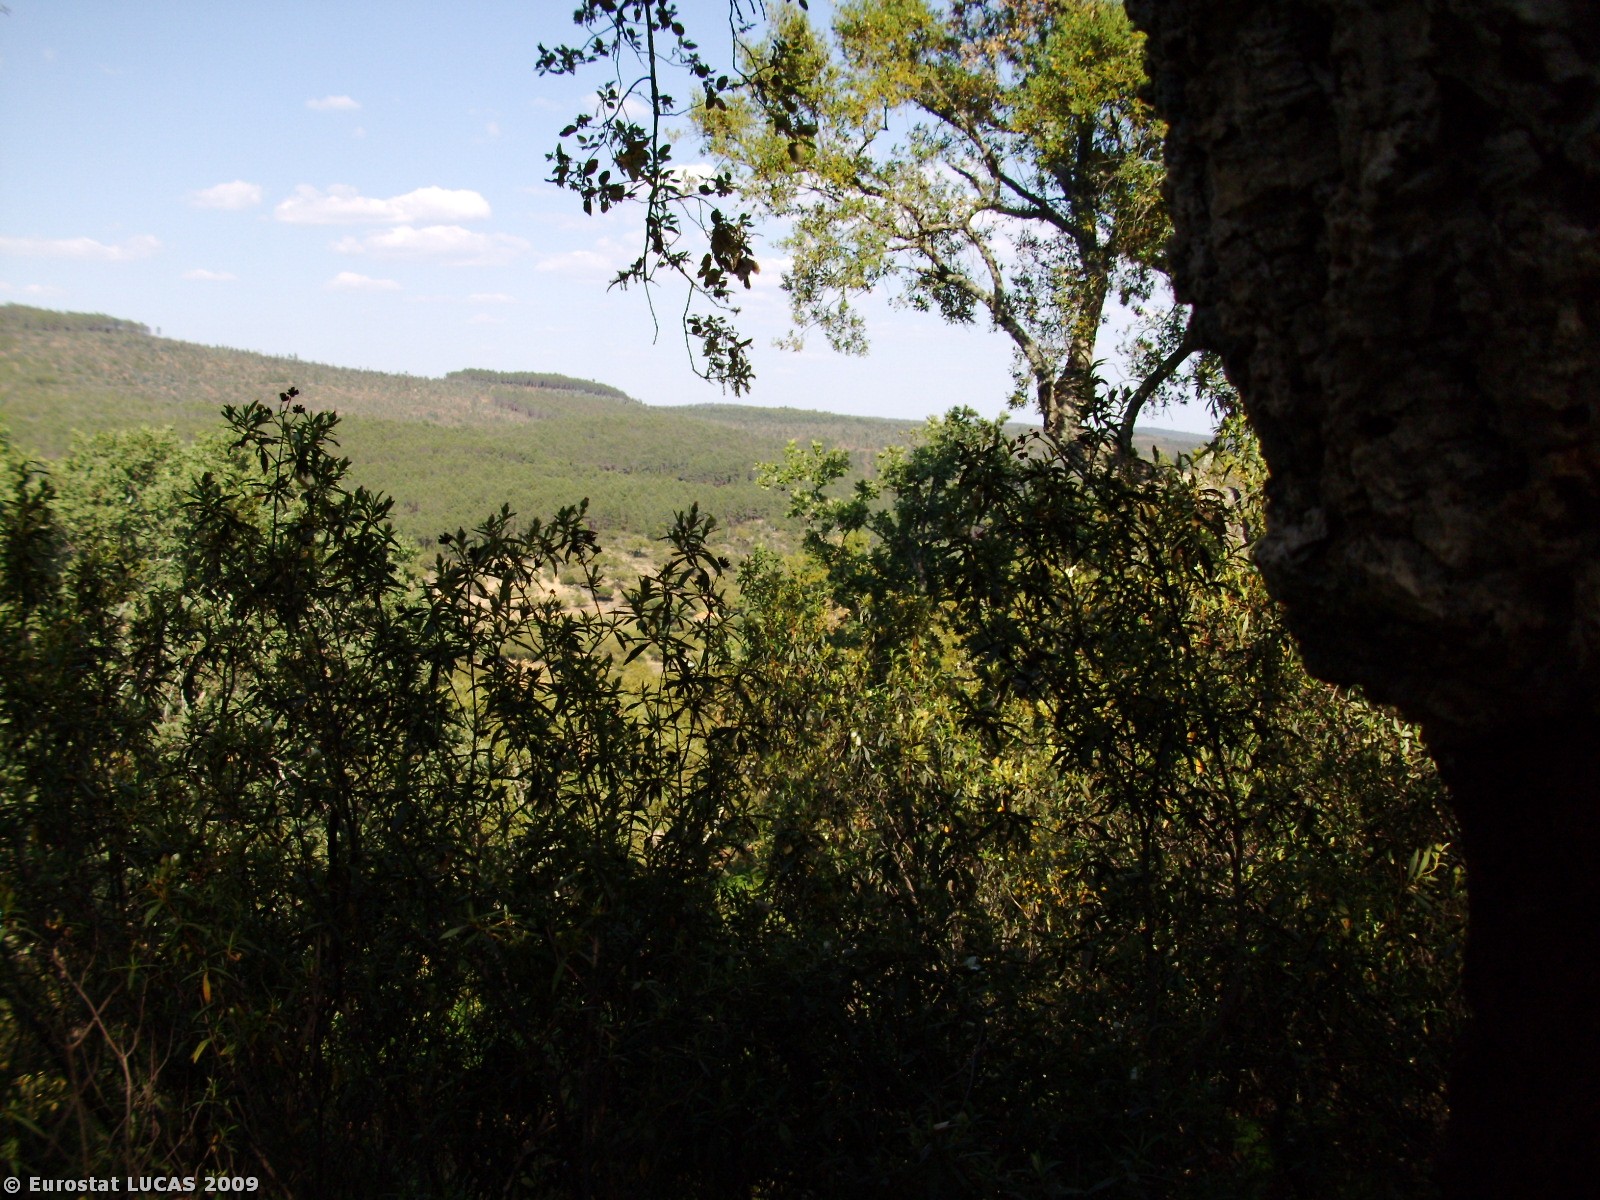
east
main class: Woodland
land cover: Broadleaved woodland
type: broadleaved evergreen forest
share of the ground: 25 - 50 %
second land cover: Shrubland with sparse tree cover
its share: 50 - 75 %
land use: Forestry
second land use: Agriculture (excluding fallow land and kitchen gardens)
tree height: > 5 m
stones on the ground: 25 - 50 %
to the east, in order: Broadleaved woodland; Shrubland with sparse tree cover; Tracks; Broadleaved woodland; Shrubland without tree cover
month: May
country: PT
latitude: 39.2456
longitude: -7.3376
